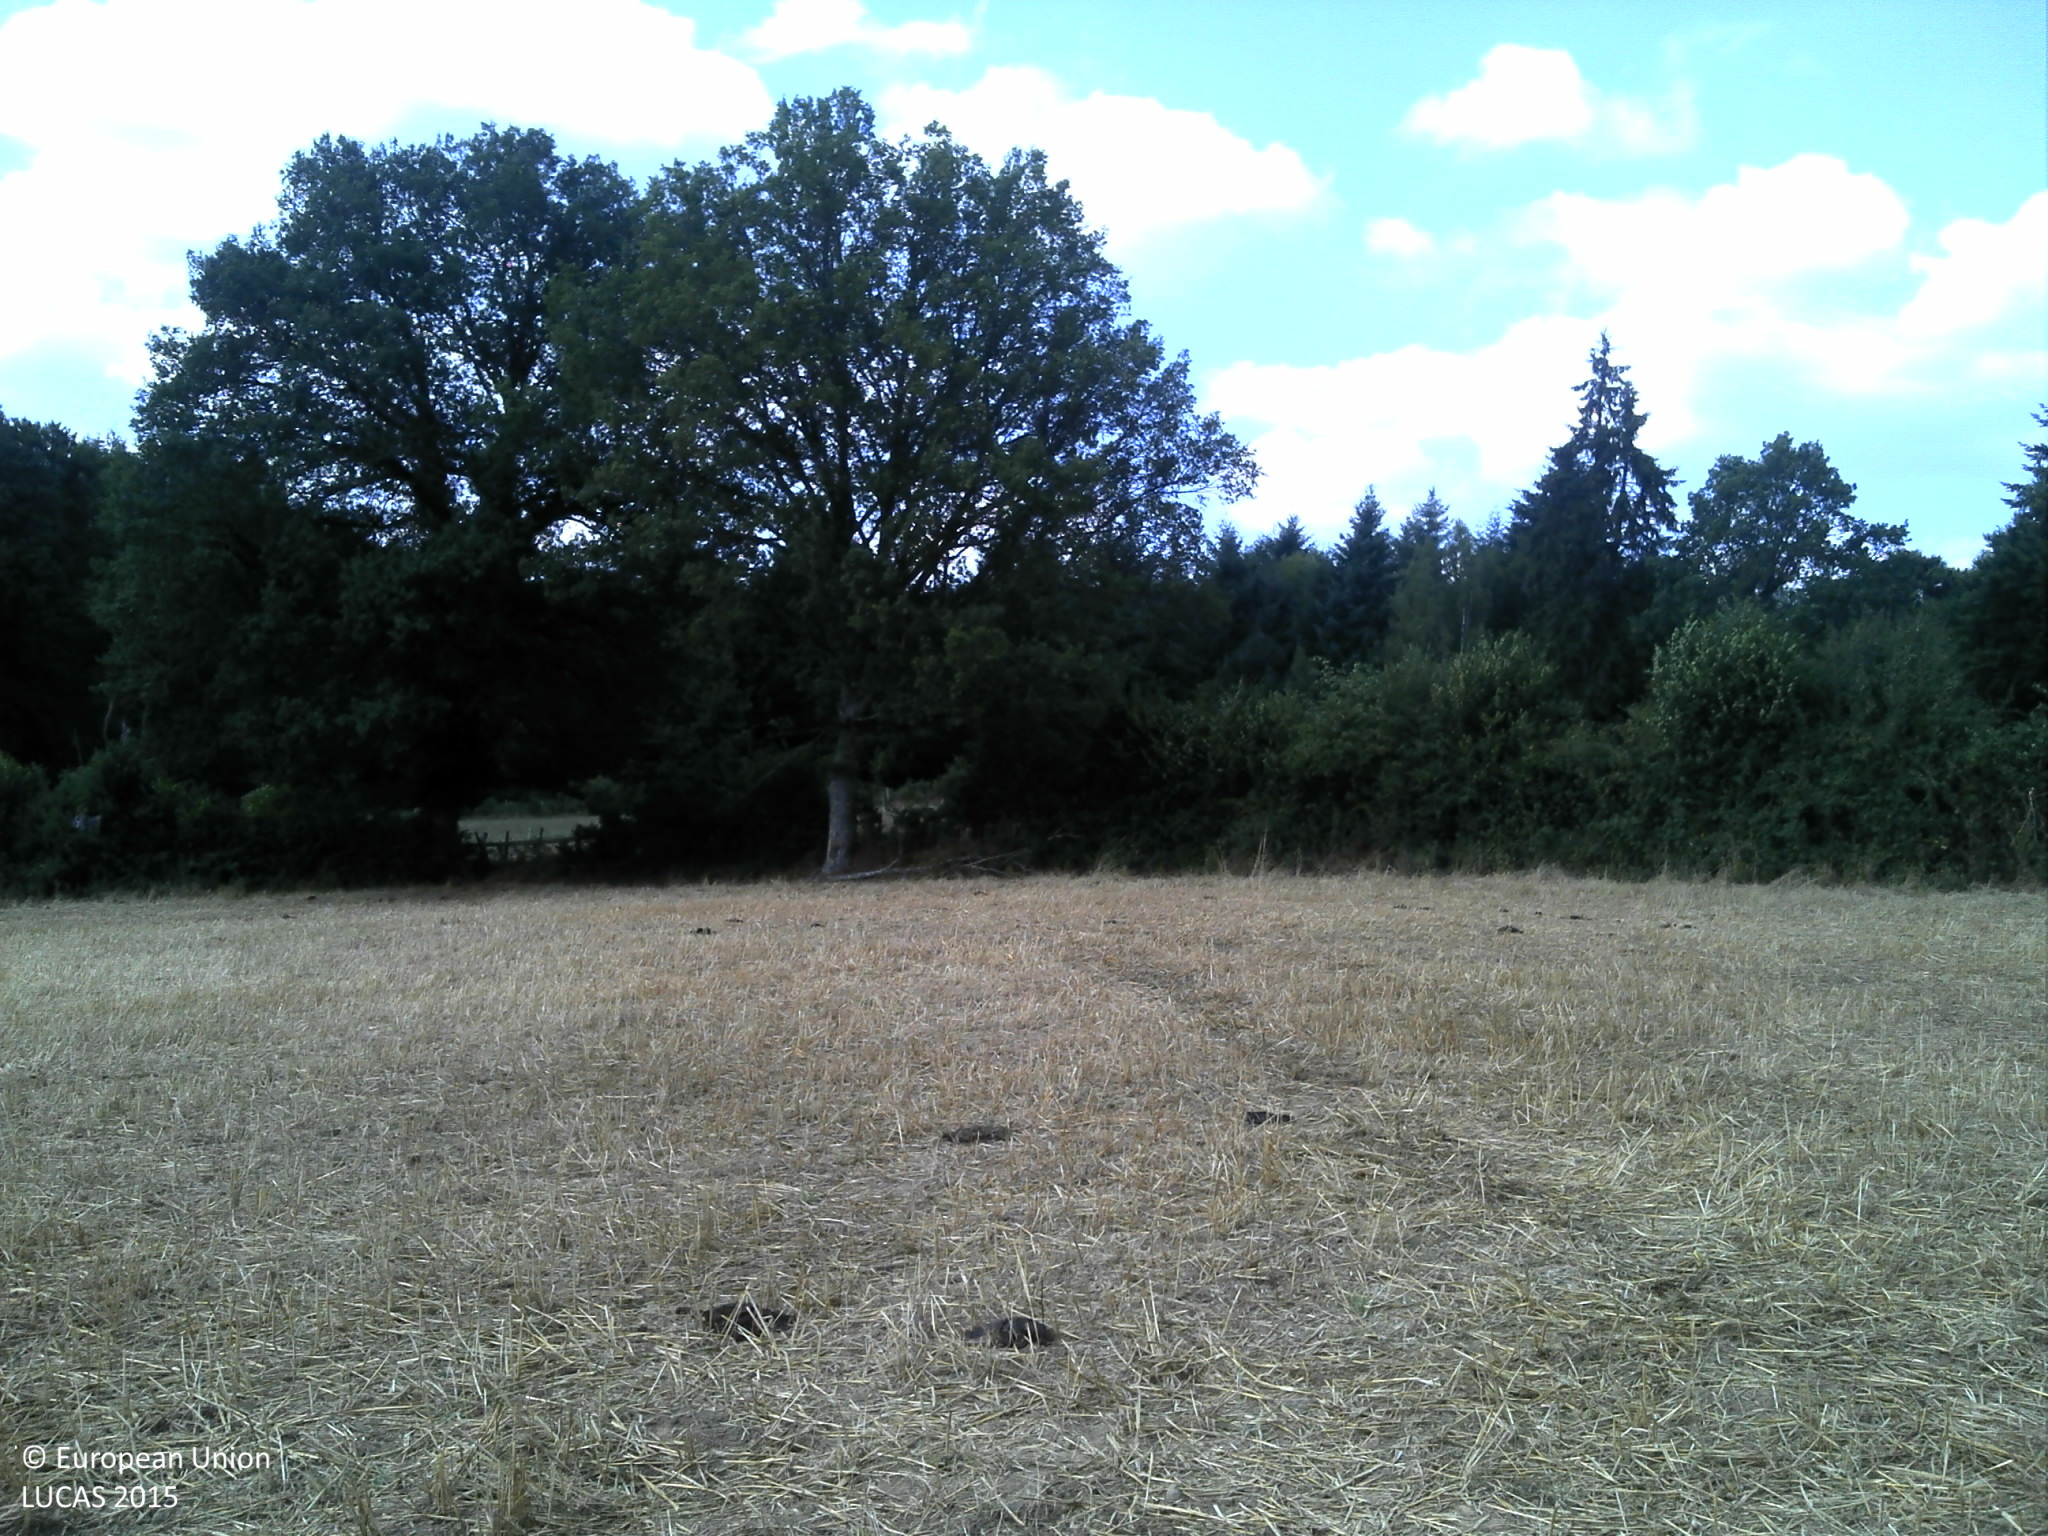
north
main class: Cropland
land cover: Common wheat
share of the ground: > 75 %
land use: Agriculture (excluding fallow land and kitchen gardens)
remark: Harvested field
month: August
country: FR
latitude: 45.5202
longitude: 2.4063
